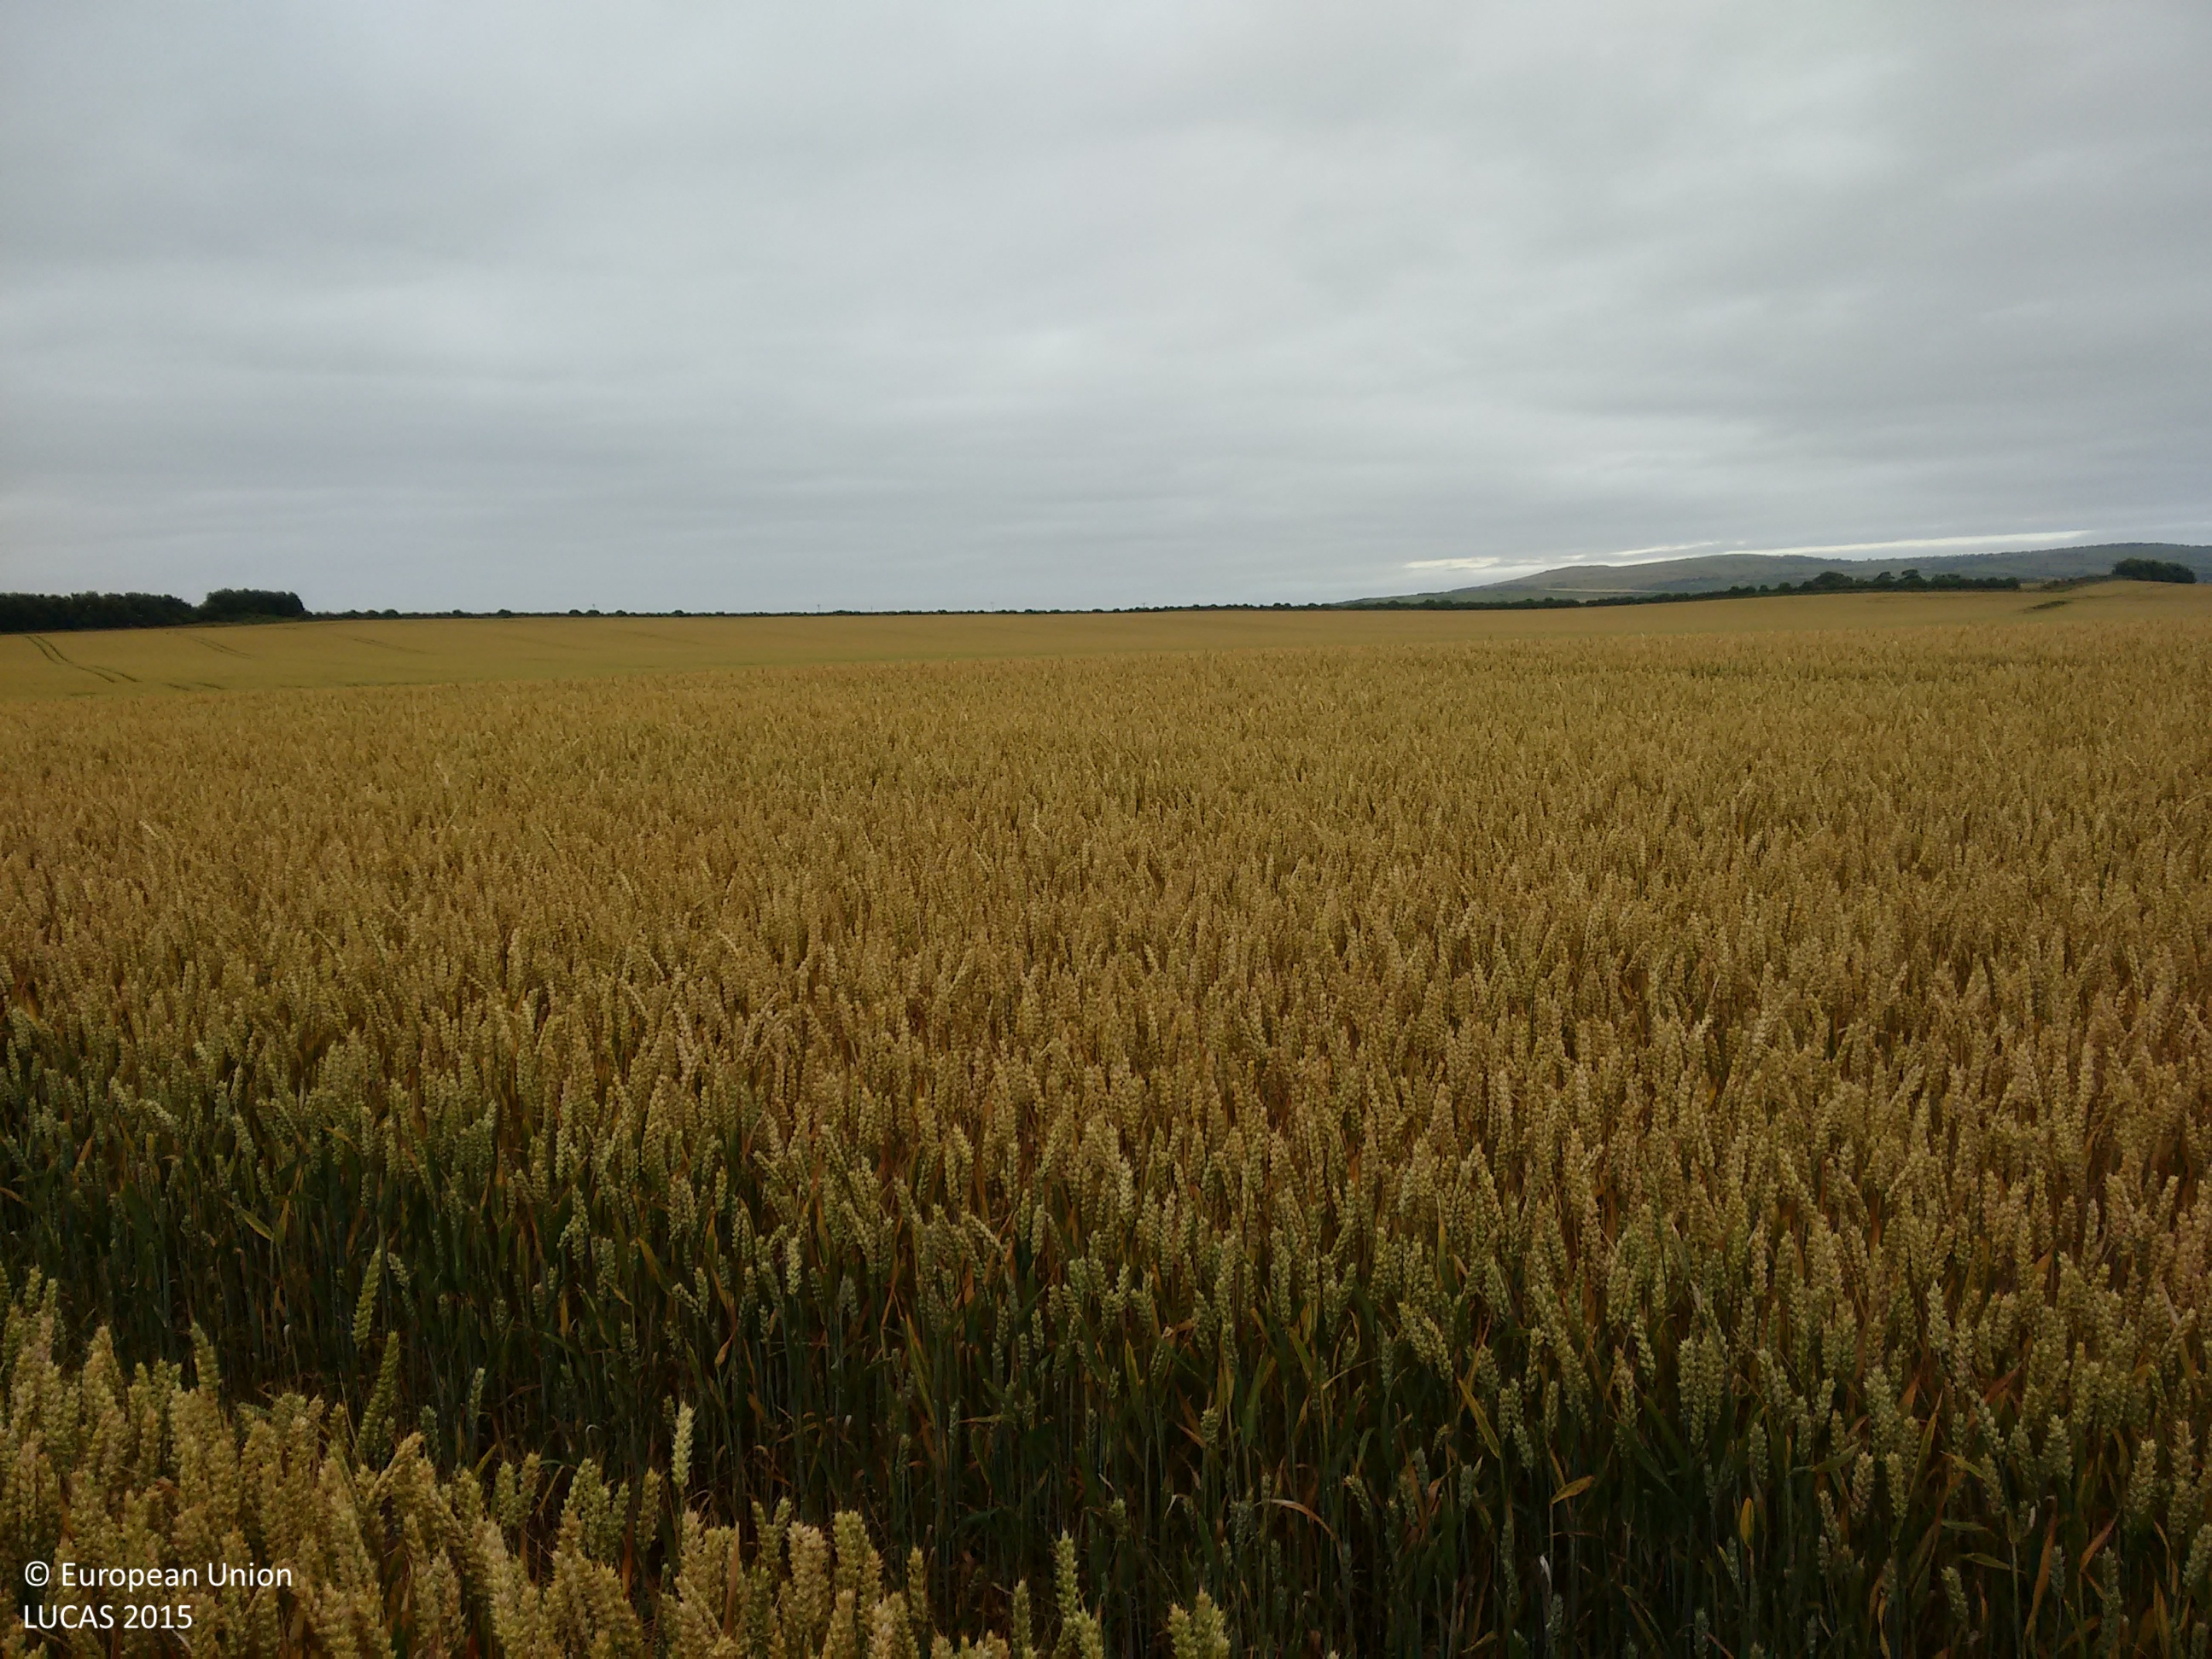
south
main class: Cropland
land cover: Common wheat
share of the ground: > 75 %
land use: Agriculture (excluding fallow land and kitchen gardens)
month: August
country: GB
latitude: 57.7655
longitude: -3.9112
